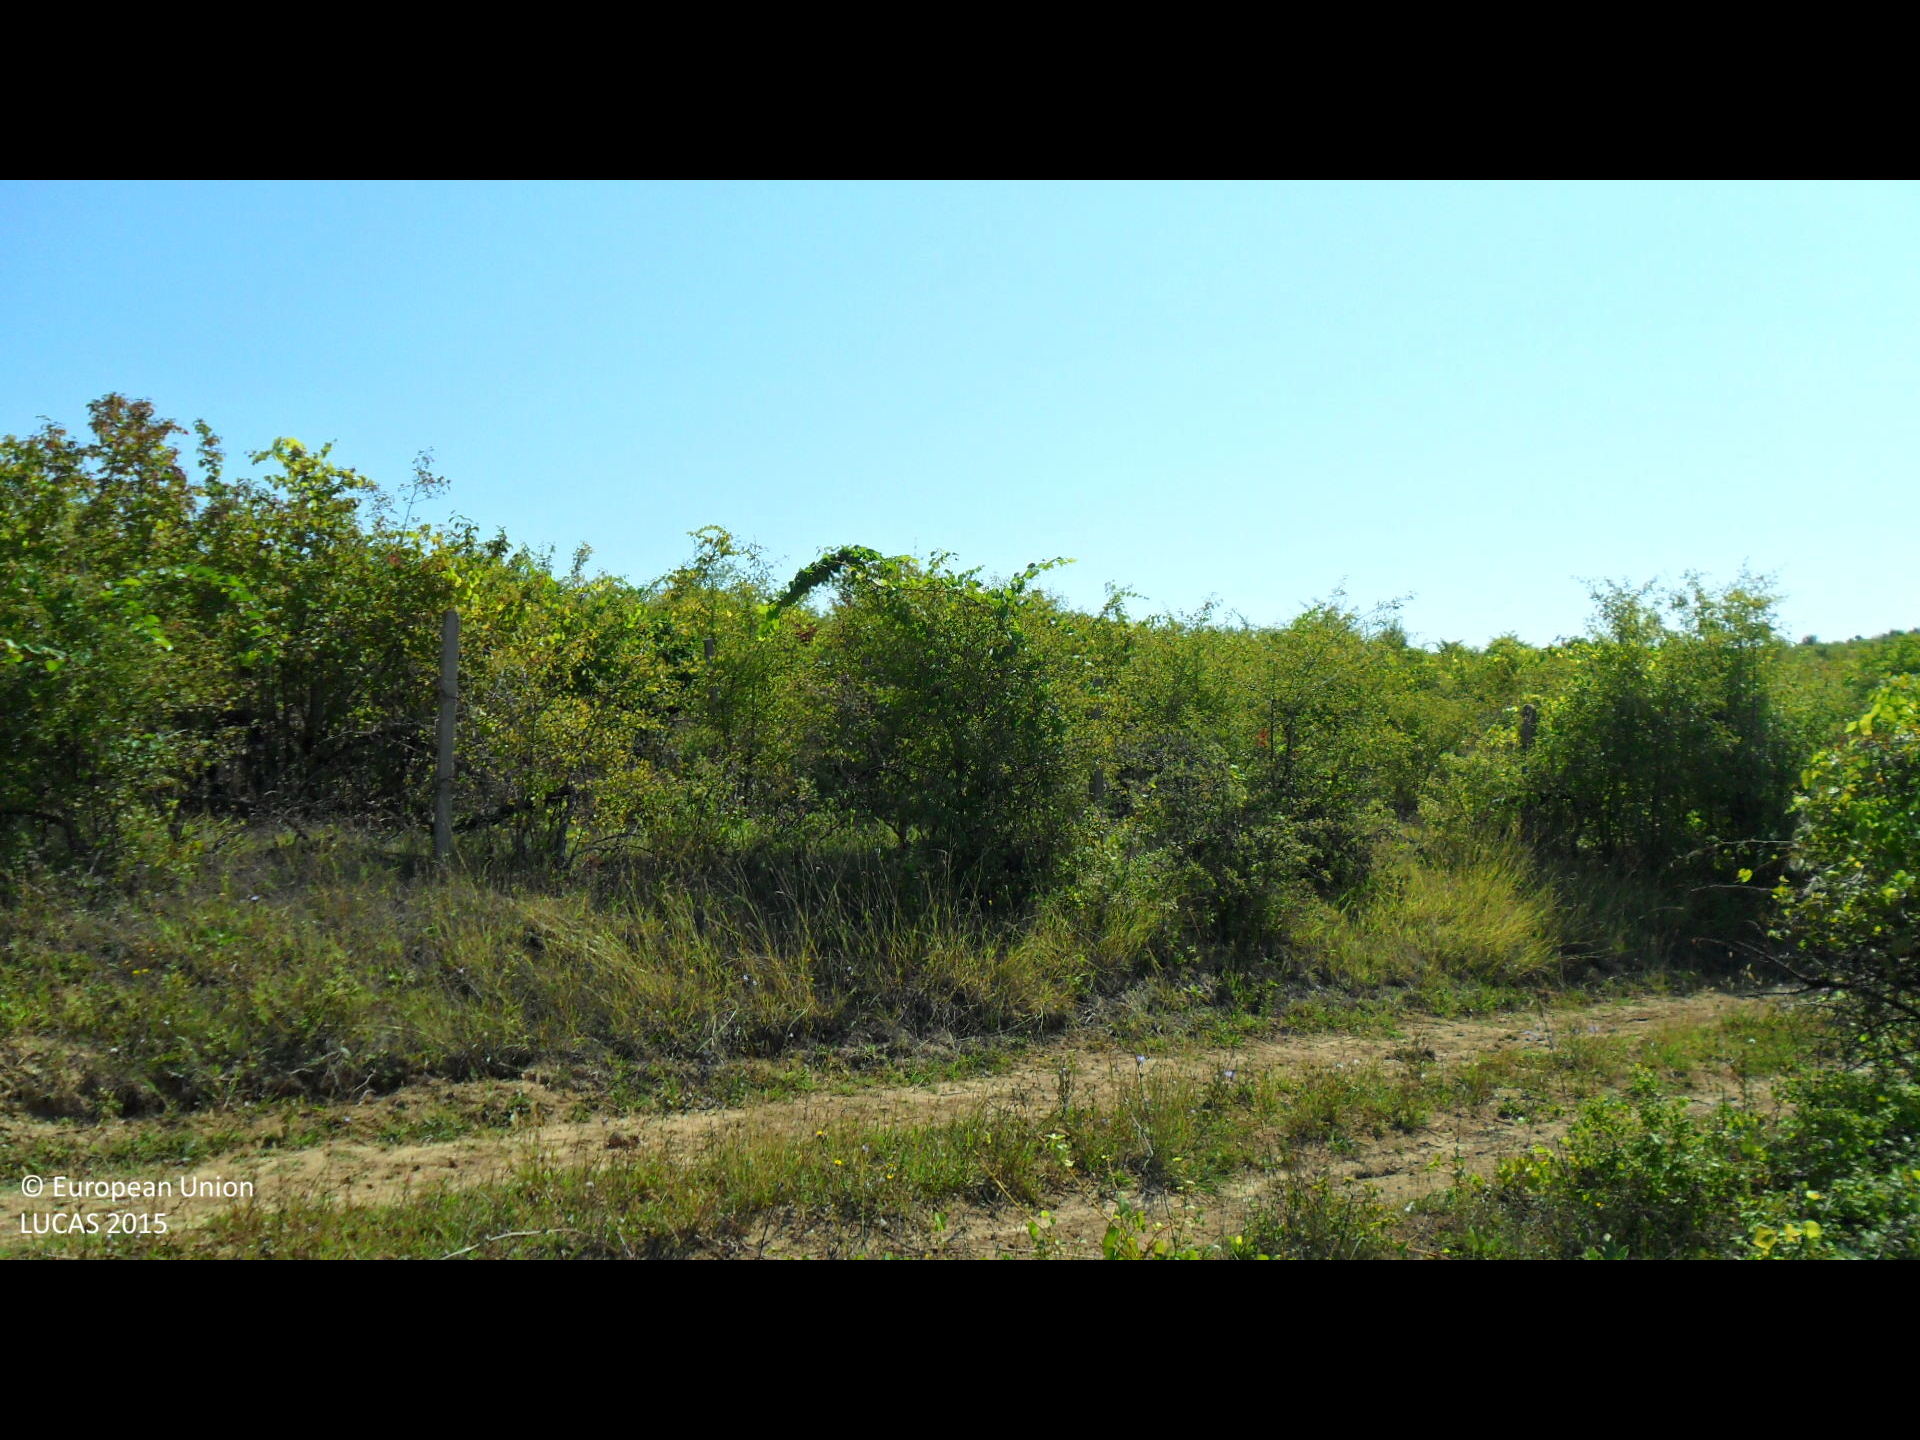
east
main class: Cropland
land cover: Vineyards
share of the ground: 50 - 75 %
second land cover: Shrubland without tree cover
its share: 50 - 75 %
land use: Abandoned areas
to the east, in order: Vineyards; Shrubland without tree cover; Grass margins; Tracks; Grass margins; Vineyards
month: August
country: BG
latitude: 43.4922
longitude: 26.1850
